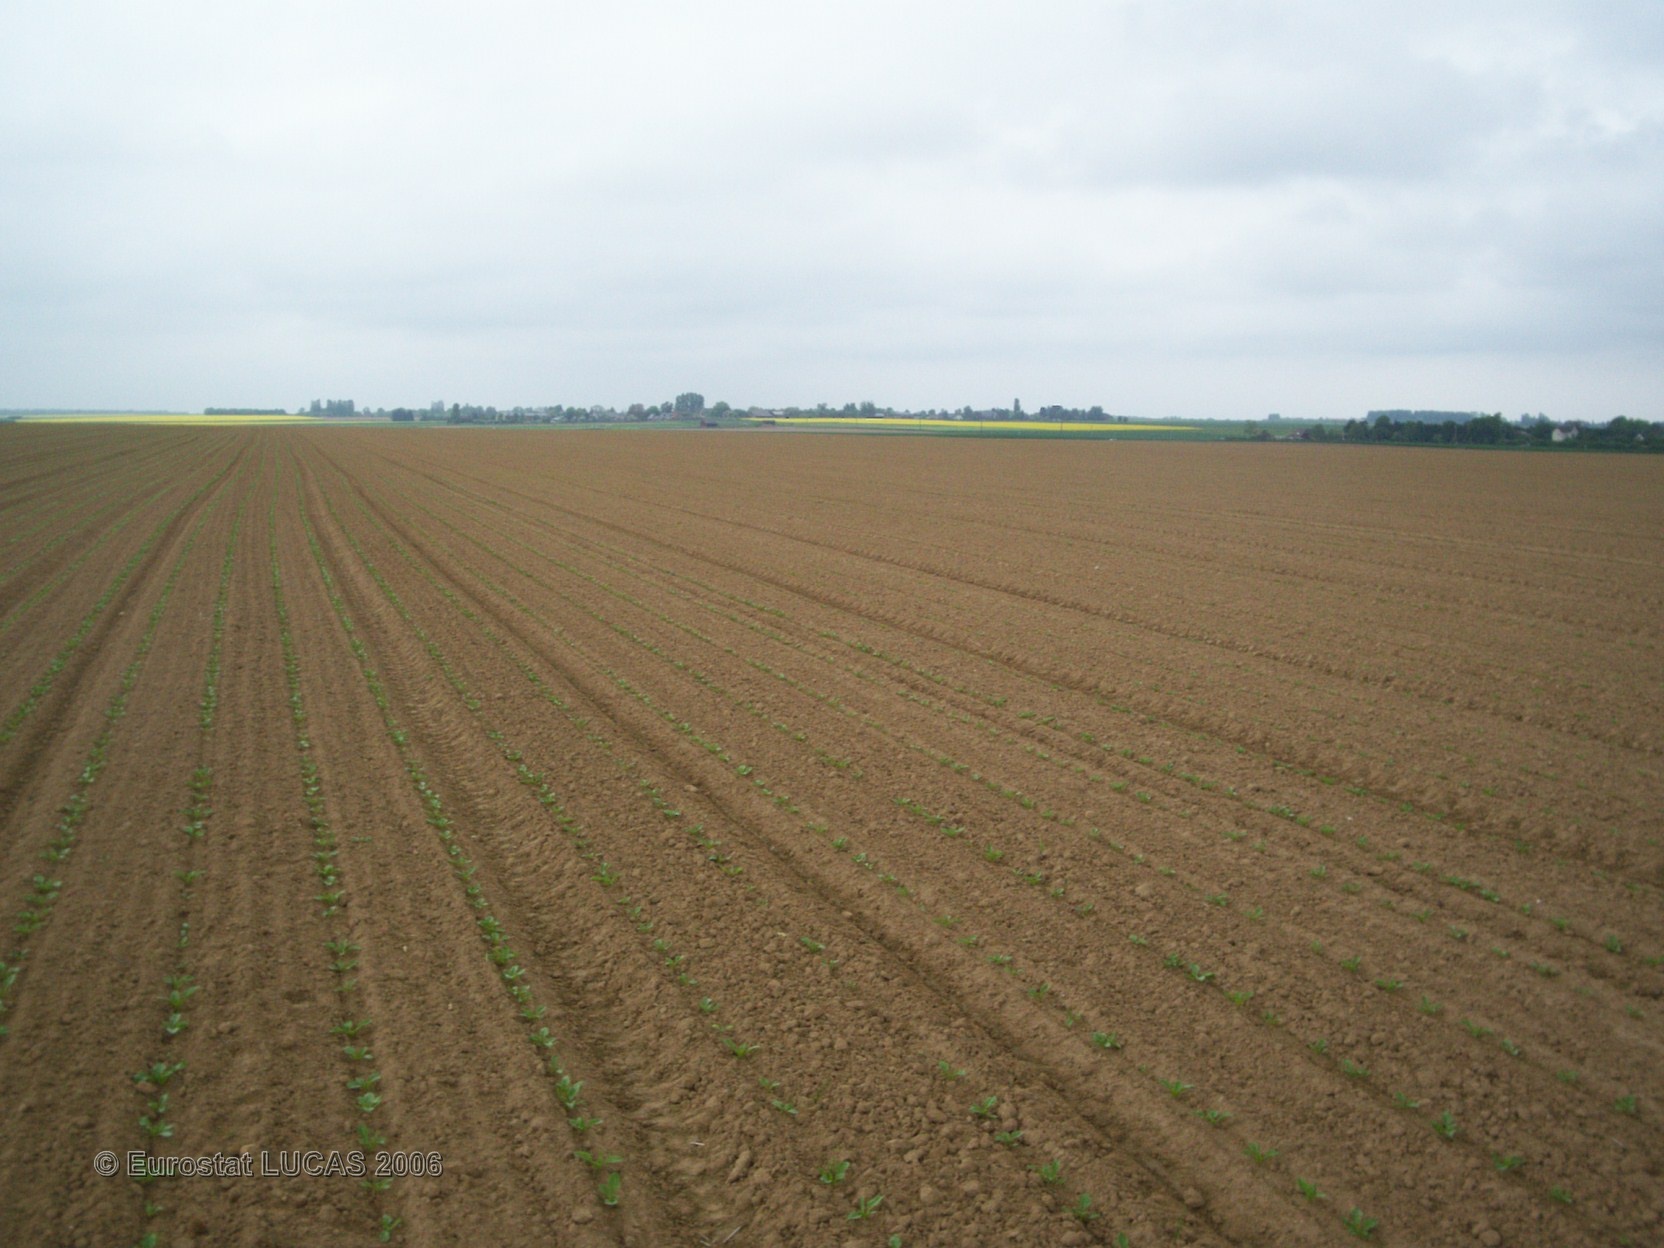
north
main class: Cropland
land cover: Sugar beet
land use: Agriculture (excluding fallow land and kitchen gardens)
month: May
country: FR
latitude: 49.1935
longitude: 0.9900
